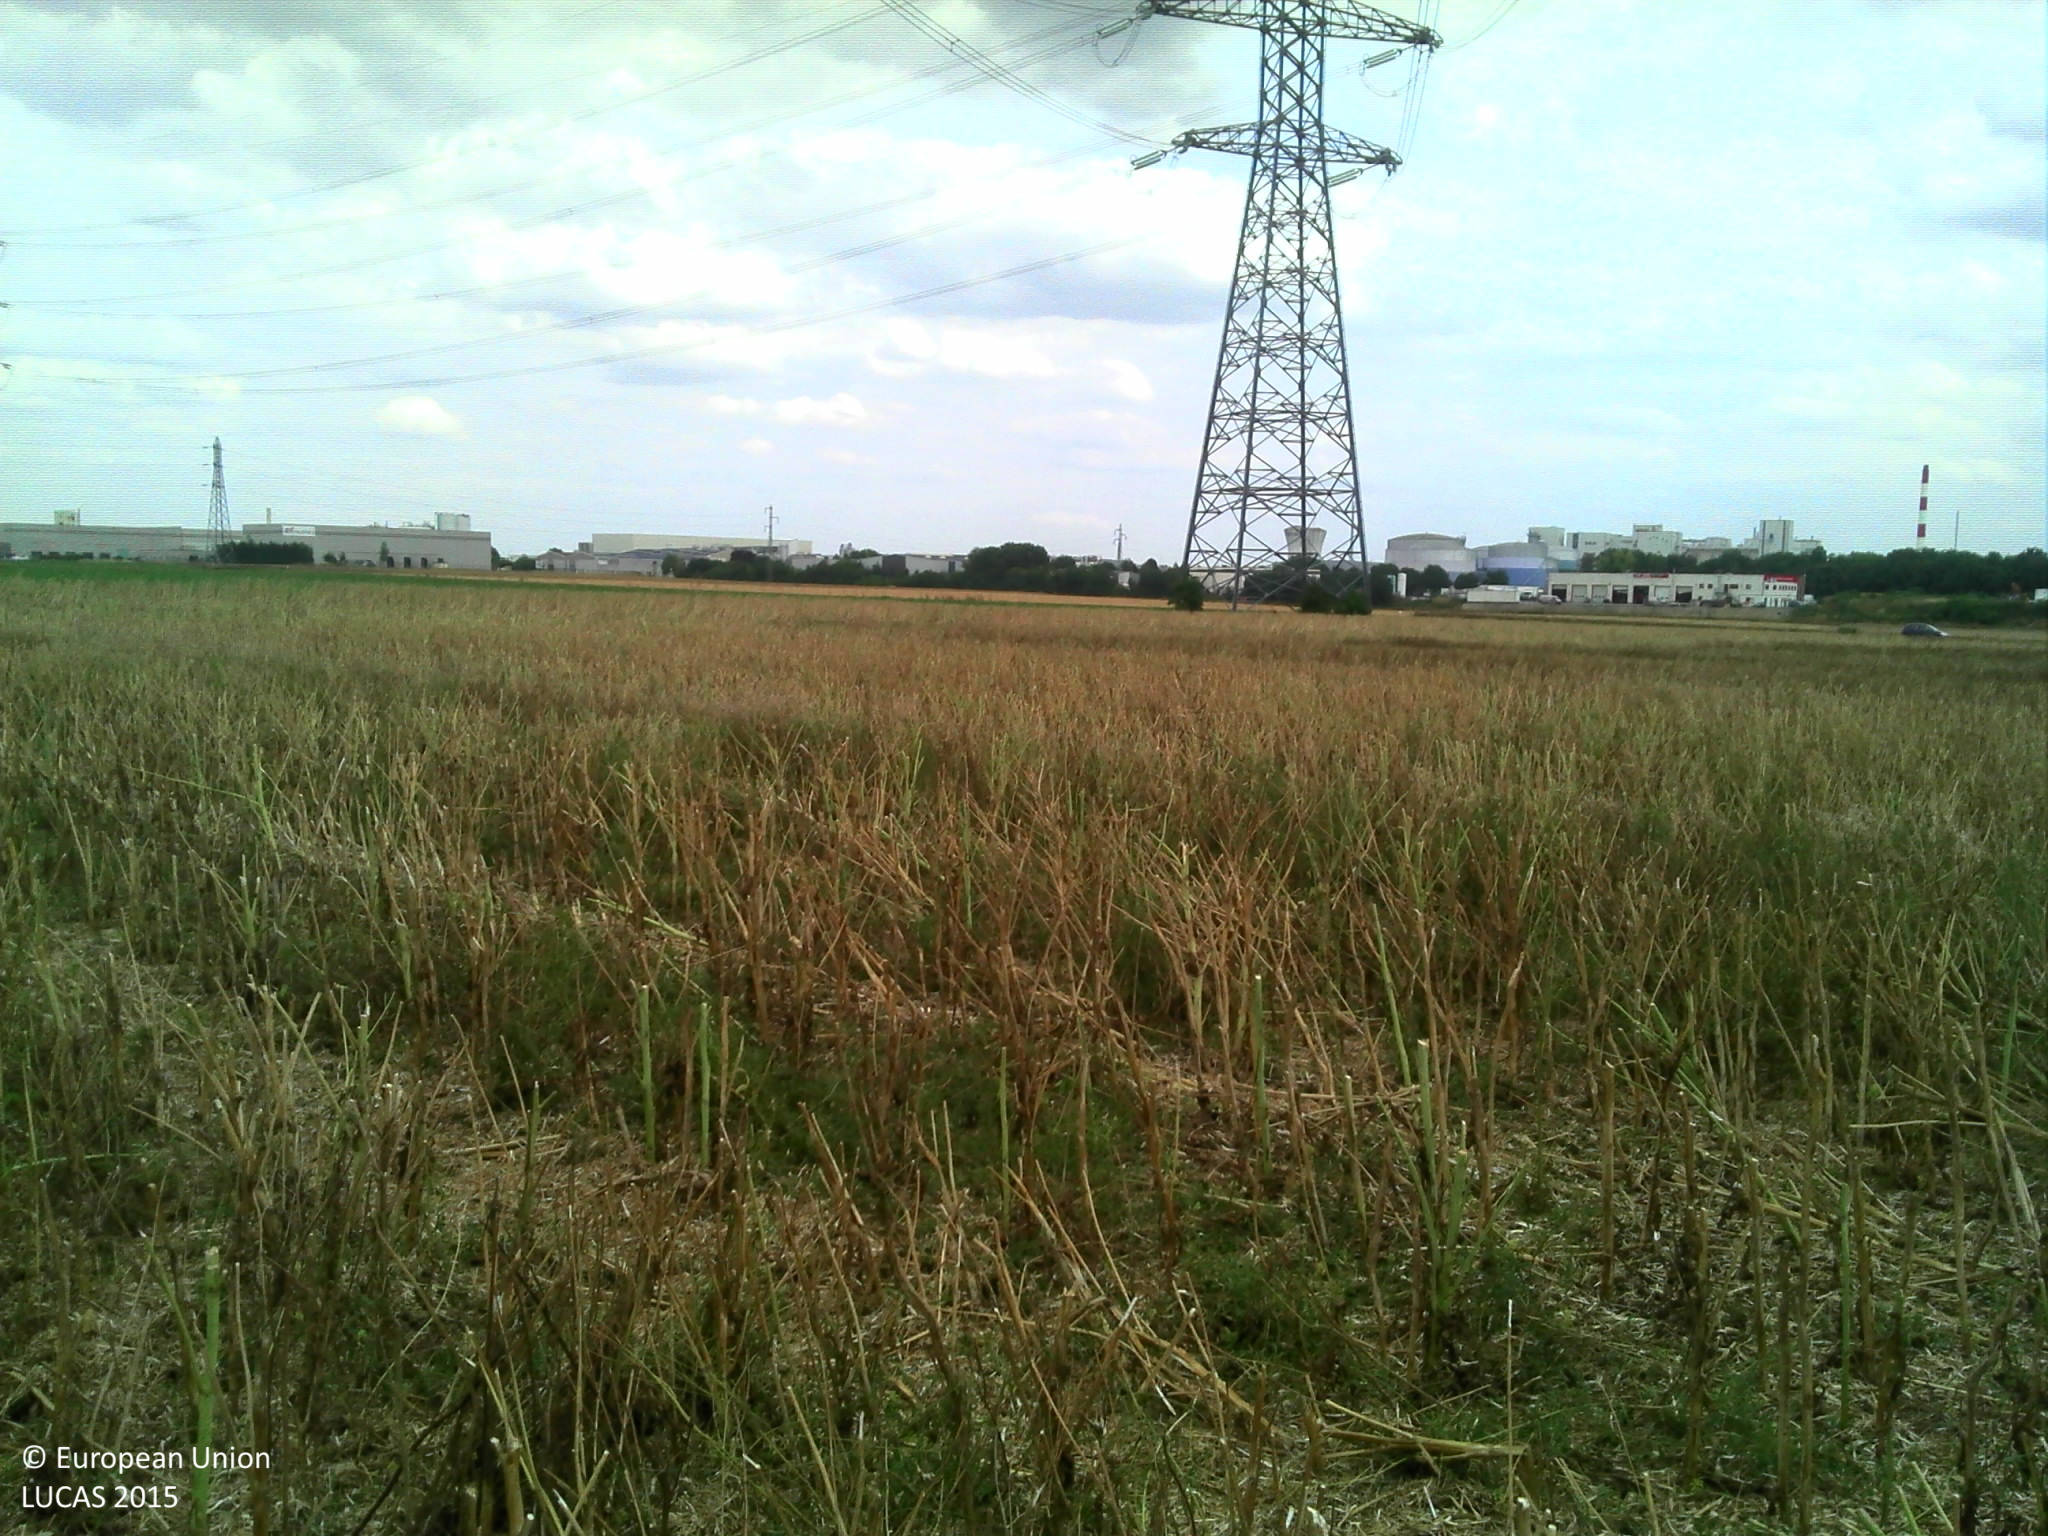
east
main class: Cropland
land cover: Rape and turnip rape
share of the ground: 25 - 50 %
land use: Agriculture (excluding fallow land and kitchen gardens)
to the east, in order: Rape and turnip rape; Electric lines; Lucerne; Electric lines; Lucerne
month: July
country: FR
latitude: 49.9385
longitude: 2.2532
